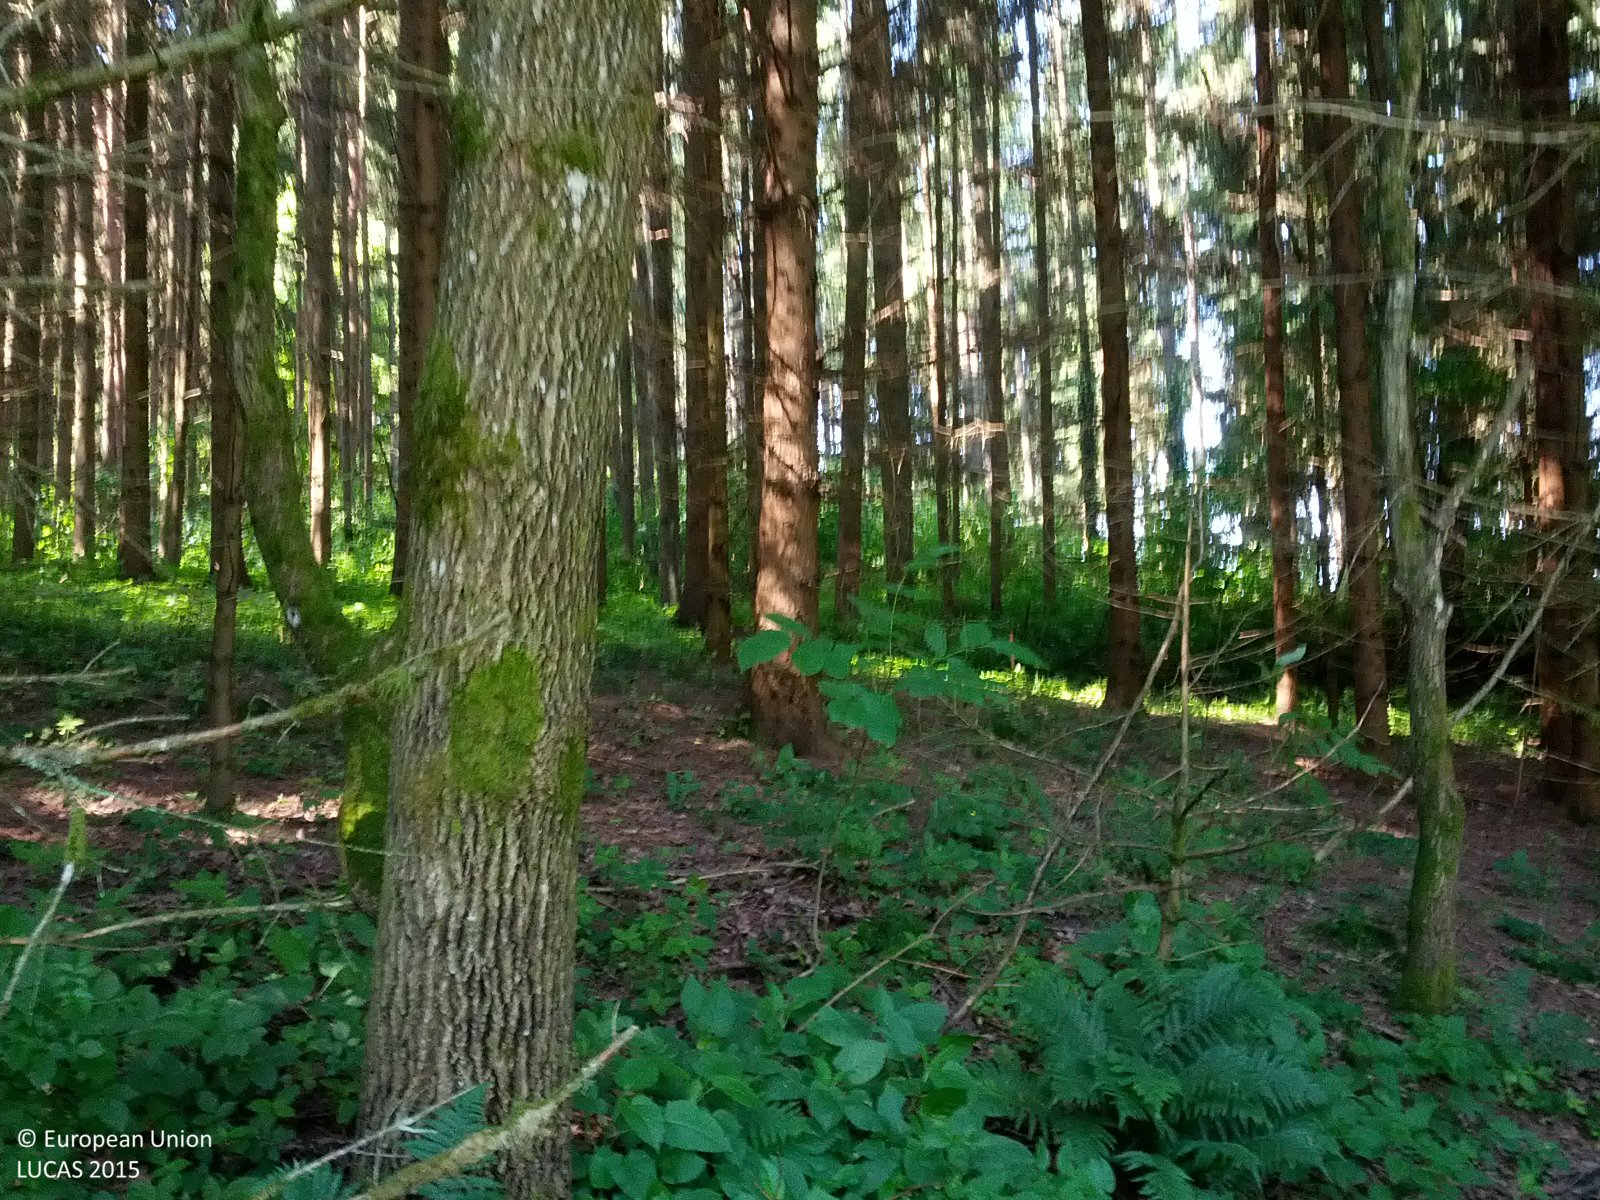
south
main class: Woodland
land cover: Spruce dominated coniferous woodland
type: hemiboreal forest and nemoral coniferous forest and mixed broadleaved-coniferous forest
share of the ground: > 75 %
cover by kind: coniferous forest trees 85 %, herbaceous plants 10 %, broadleaved forest trees 5 %
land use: Forestry
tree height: > 5 m
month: June
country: AT
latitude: 47.2025
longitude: 16.1669
